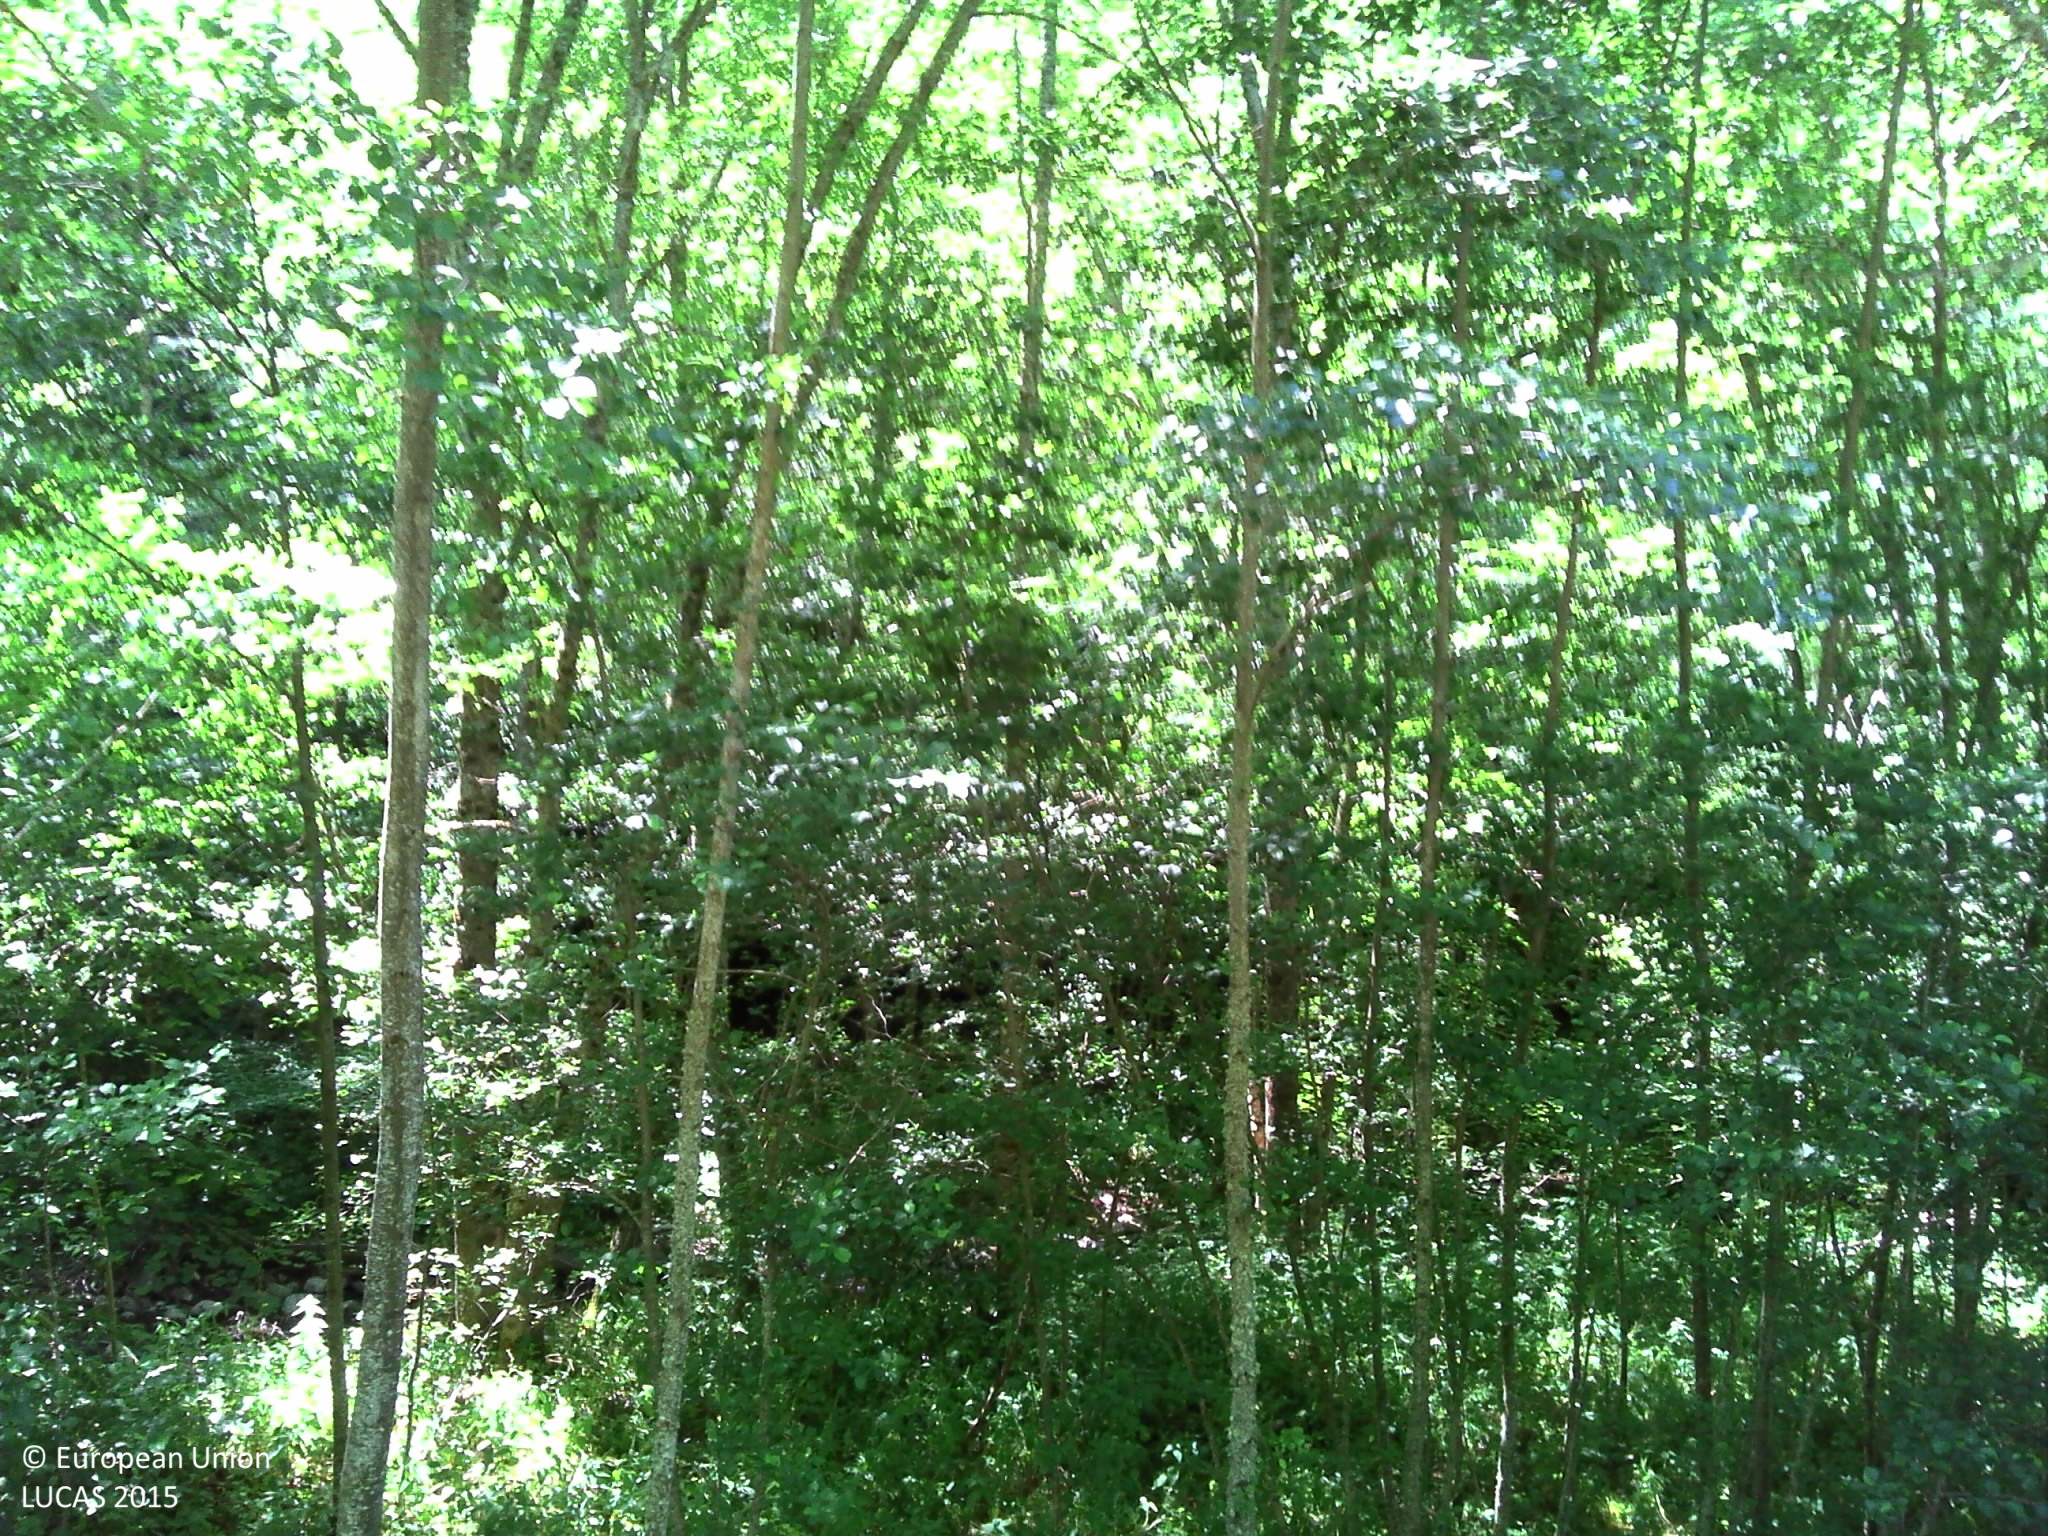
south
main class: Woodland
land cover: Broadleaved woodland
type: mesophytic deciduous forest
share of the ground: > 75 %
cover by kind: broadleaved forest trees 90 %, herbaceous plants 10 %
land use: Semi-natural and natural areas not in use
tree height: > 5 m
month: July
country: FR
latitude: 42.7266
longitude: 2.1083
